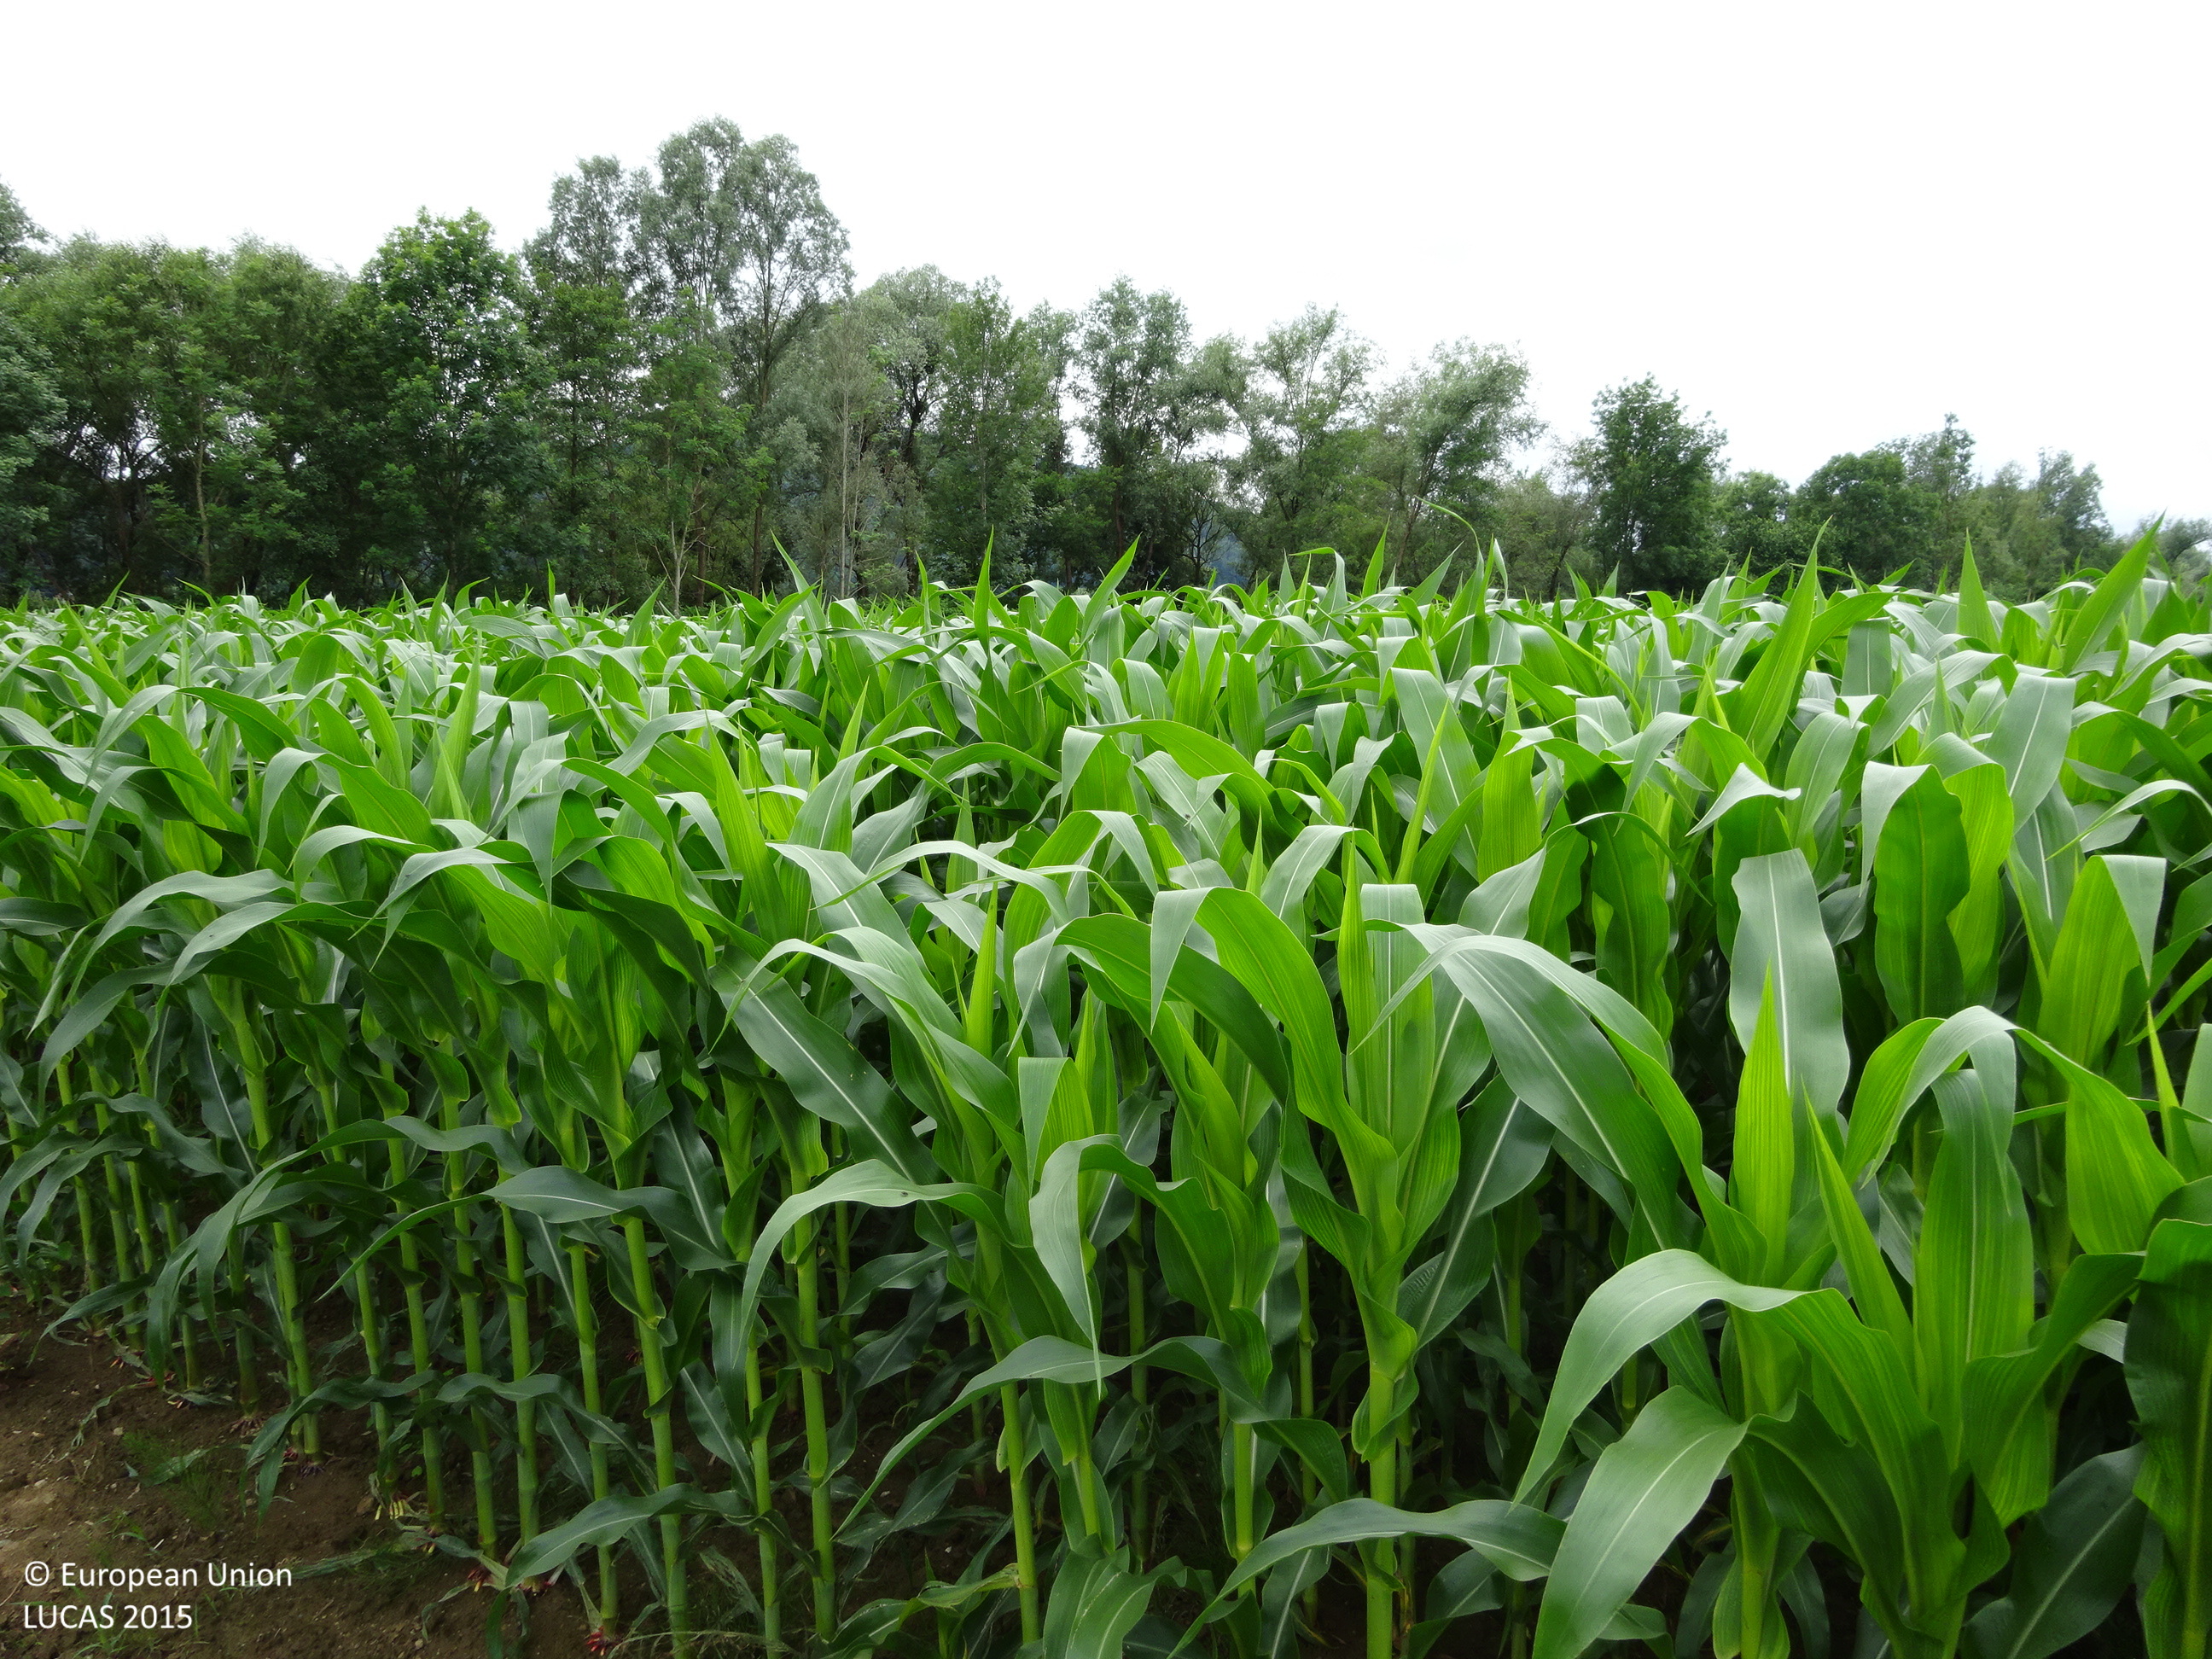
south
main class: Cropland
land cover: Maize
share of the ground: > 75 %
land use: Agriculture (excluding fallow land and kitchen gardens)
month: June
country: AT
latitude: 46.7367
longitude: 15.4302
